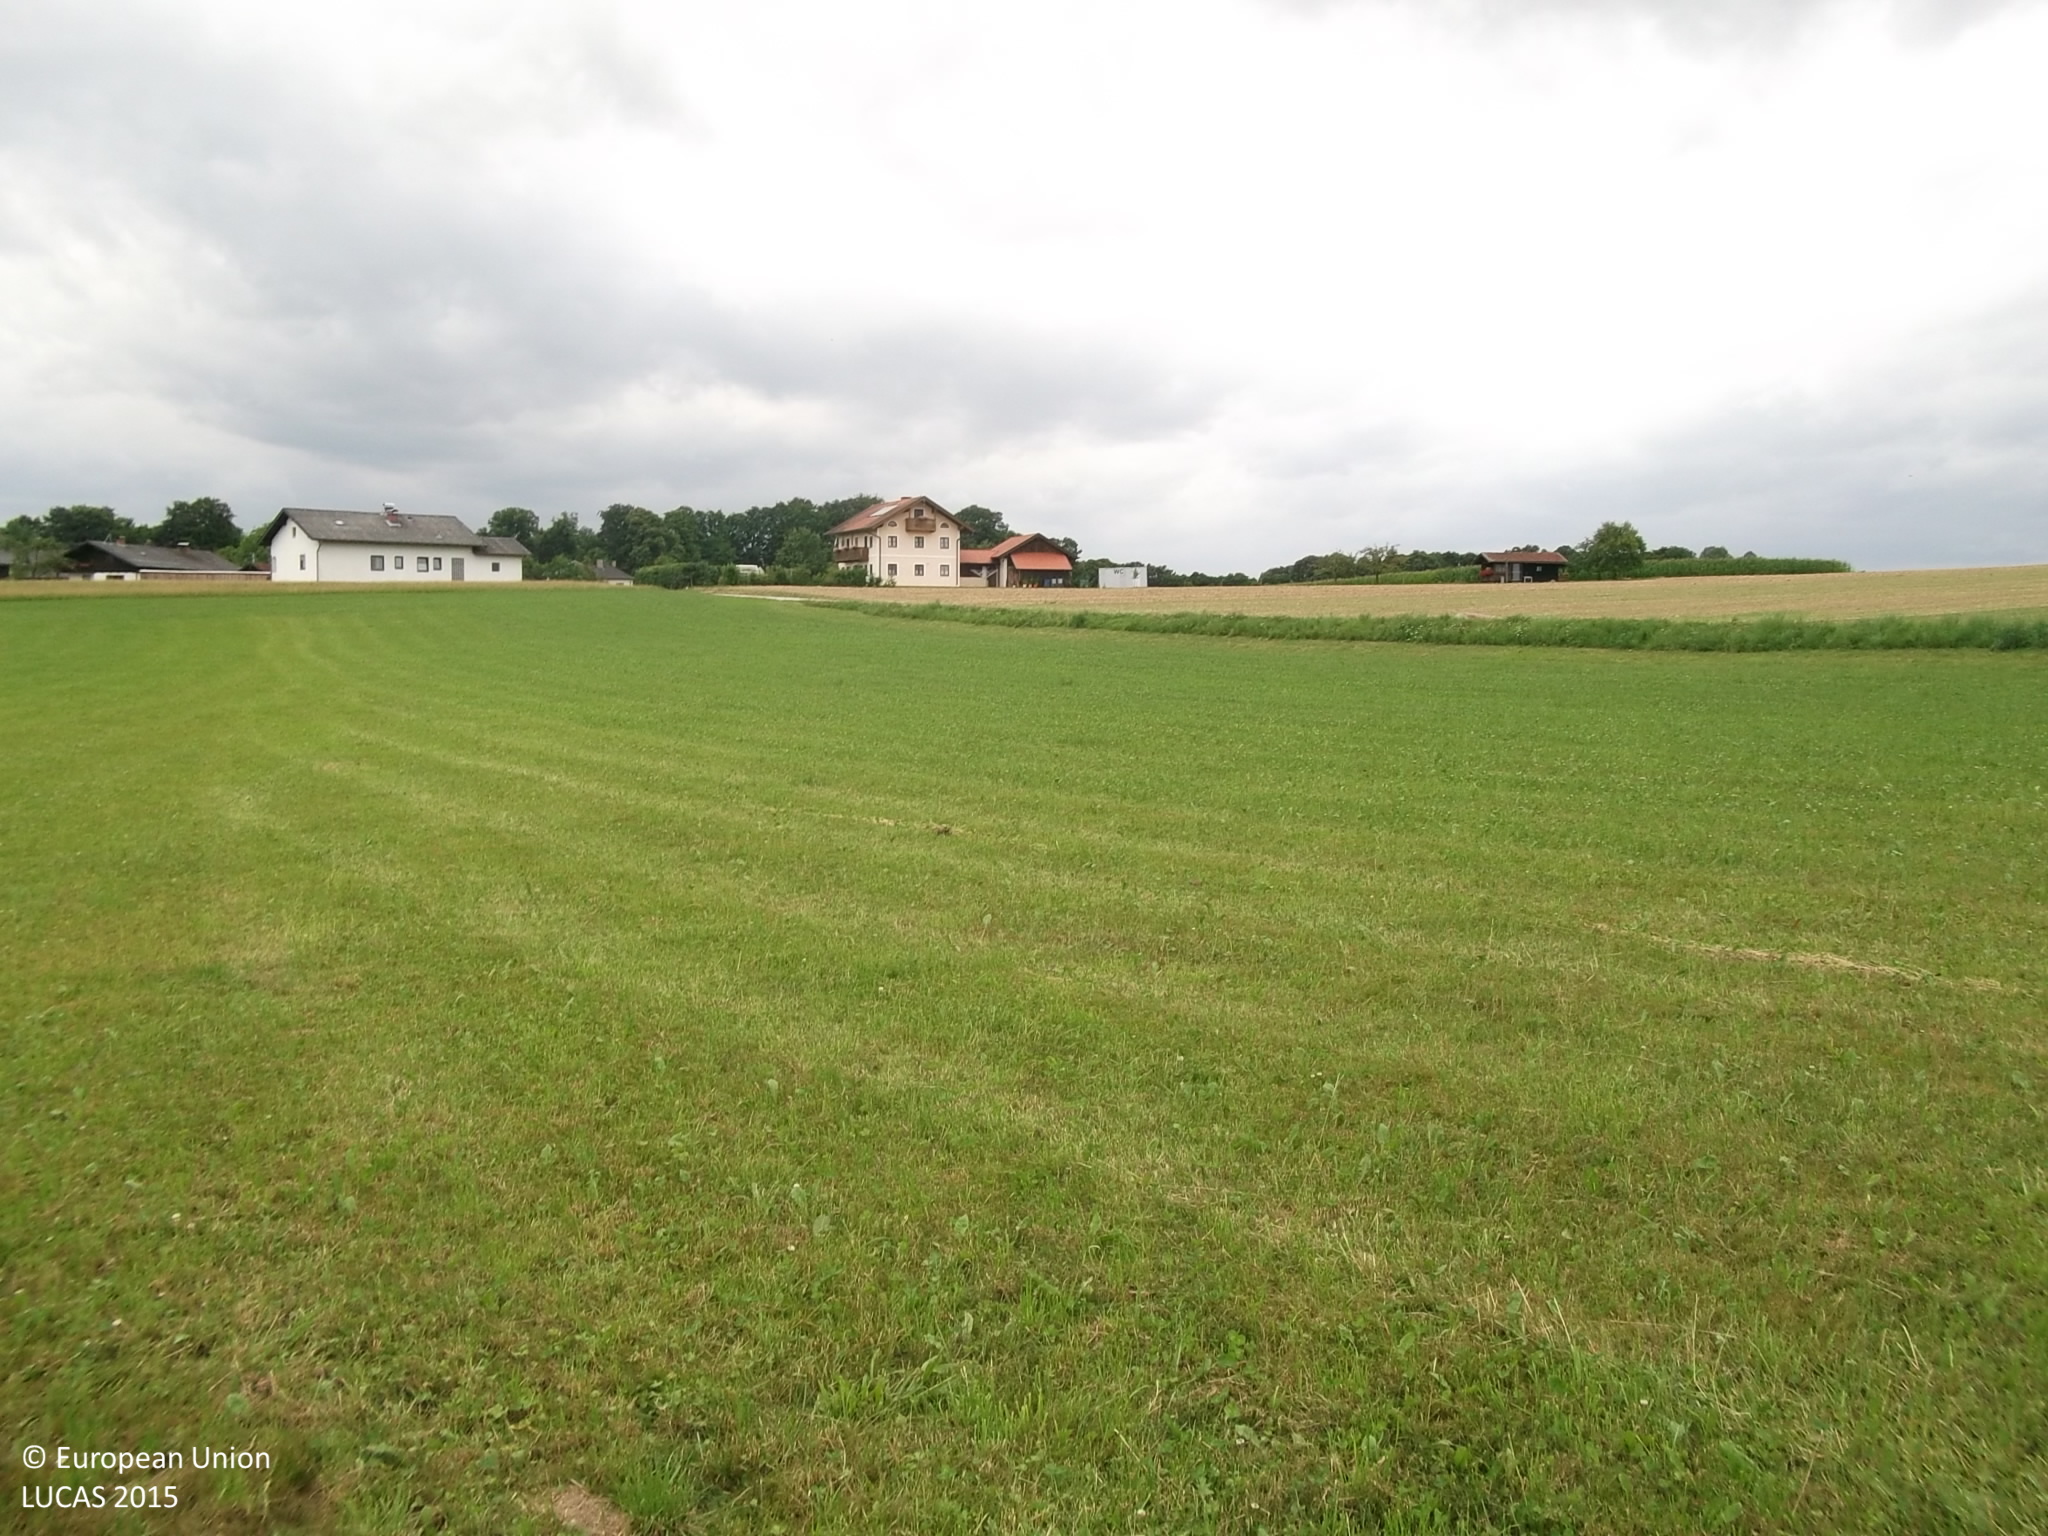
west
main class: Grassland
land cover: Grassland without tree/shrub cover
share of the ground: > 75 %
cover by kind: herbaceous plants 100 %
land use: Agriculture (excluding fallow land and kitchen gardens)
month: July
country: AT
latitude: 48.0619
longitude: 12.8033
